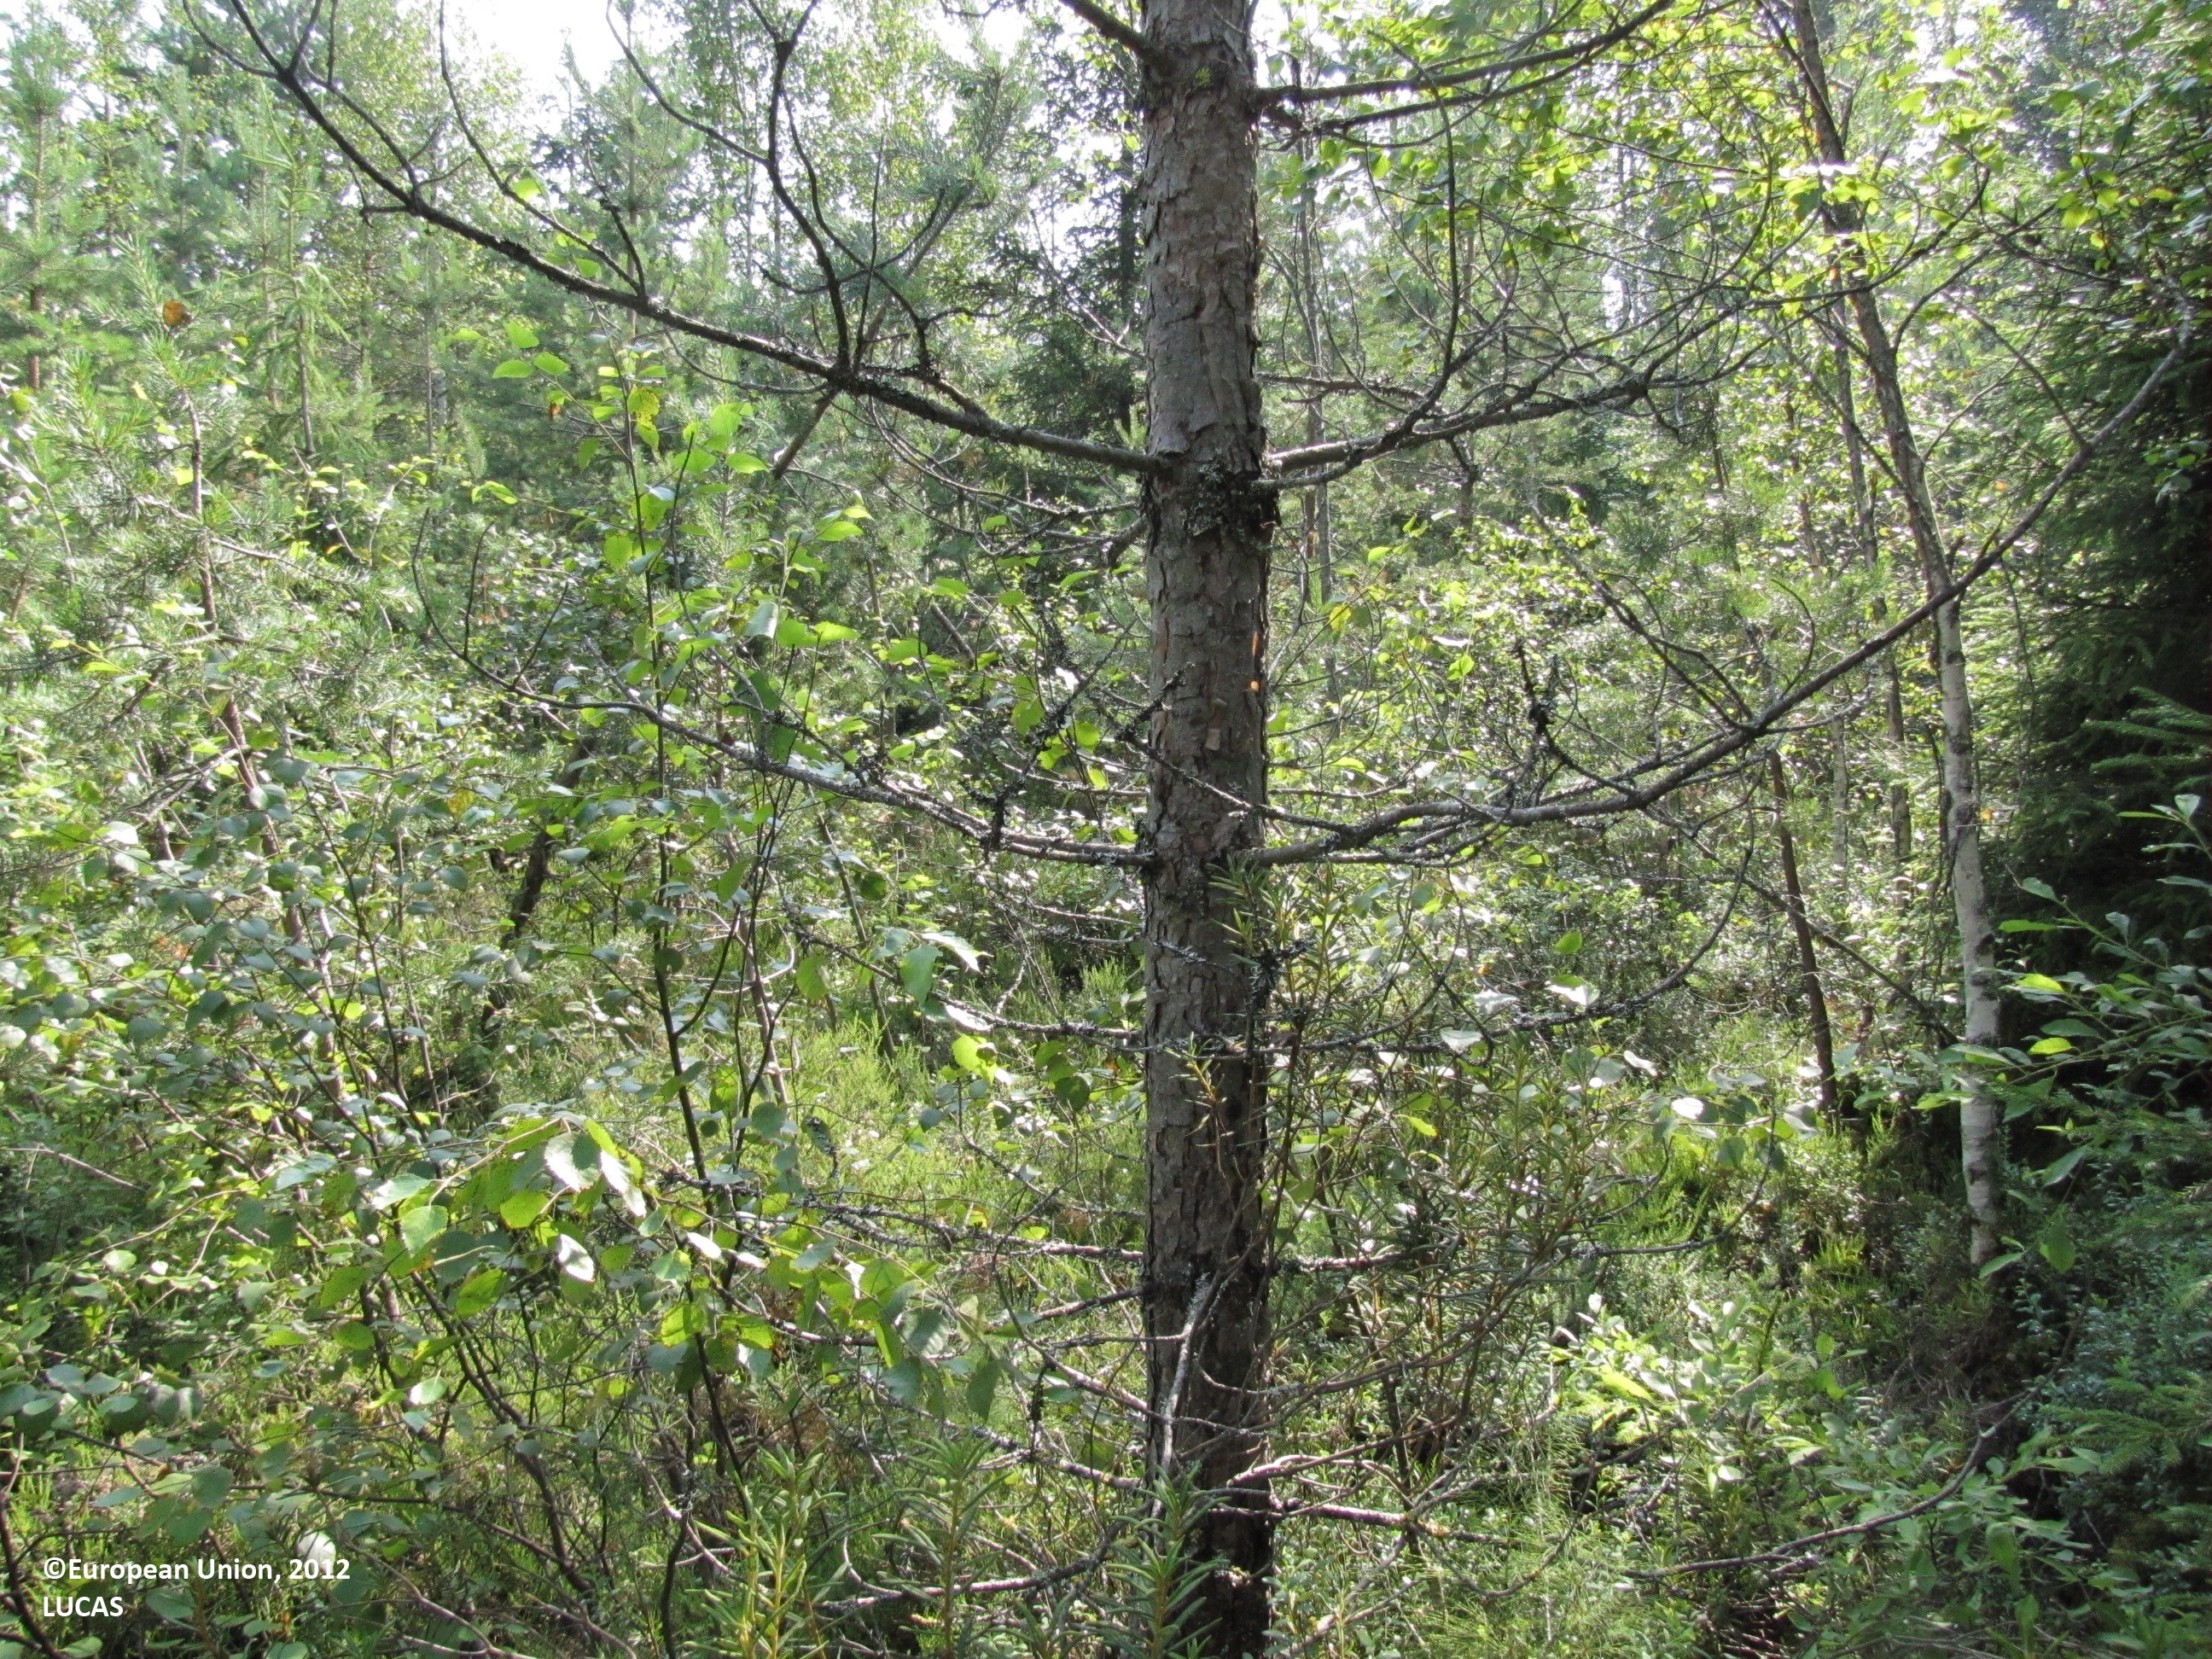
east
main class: Woodland
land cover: Other mixed woodland
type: boreal forest
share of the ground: 50 - 75 %
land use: Forestry
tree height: > 5 m
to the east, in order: Other mixed woodland; Pine dominated mixed woodland; Ditches and canals; Pine dominated mixed woodland; Ditches and canals; Abandoned hedges; Tracks; Abandoned hedges; Ditches and canals; Pine dominated mixed woodland; Ditches and canals; Pine dominated mixed woodland; Ditches and canals; Pine dominated mixed woodland; Other mixed woodland
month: July
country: FI
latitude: 62.0280
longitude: 23.1996
